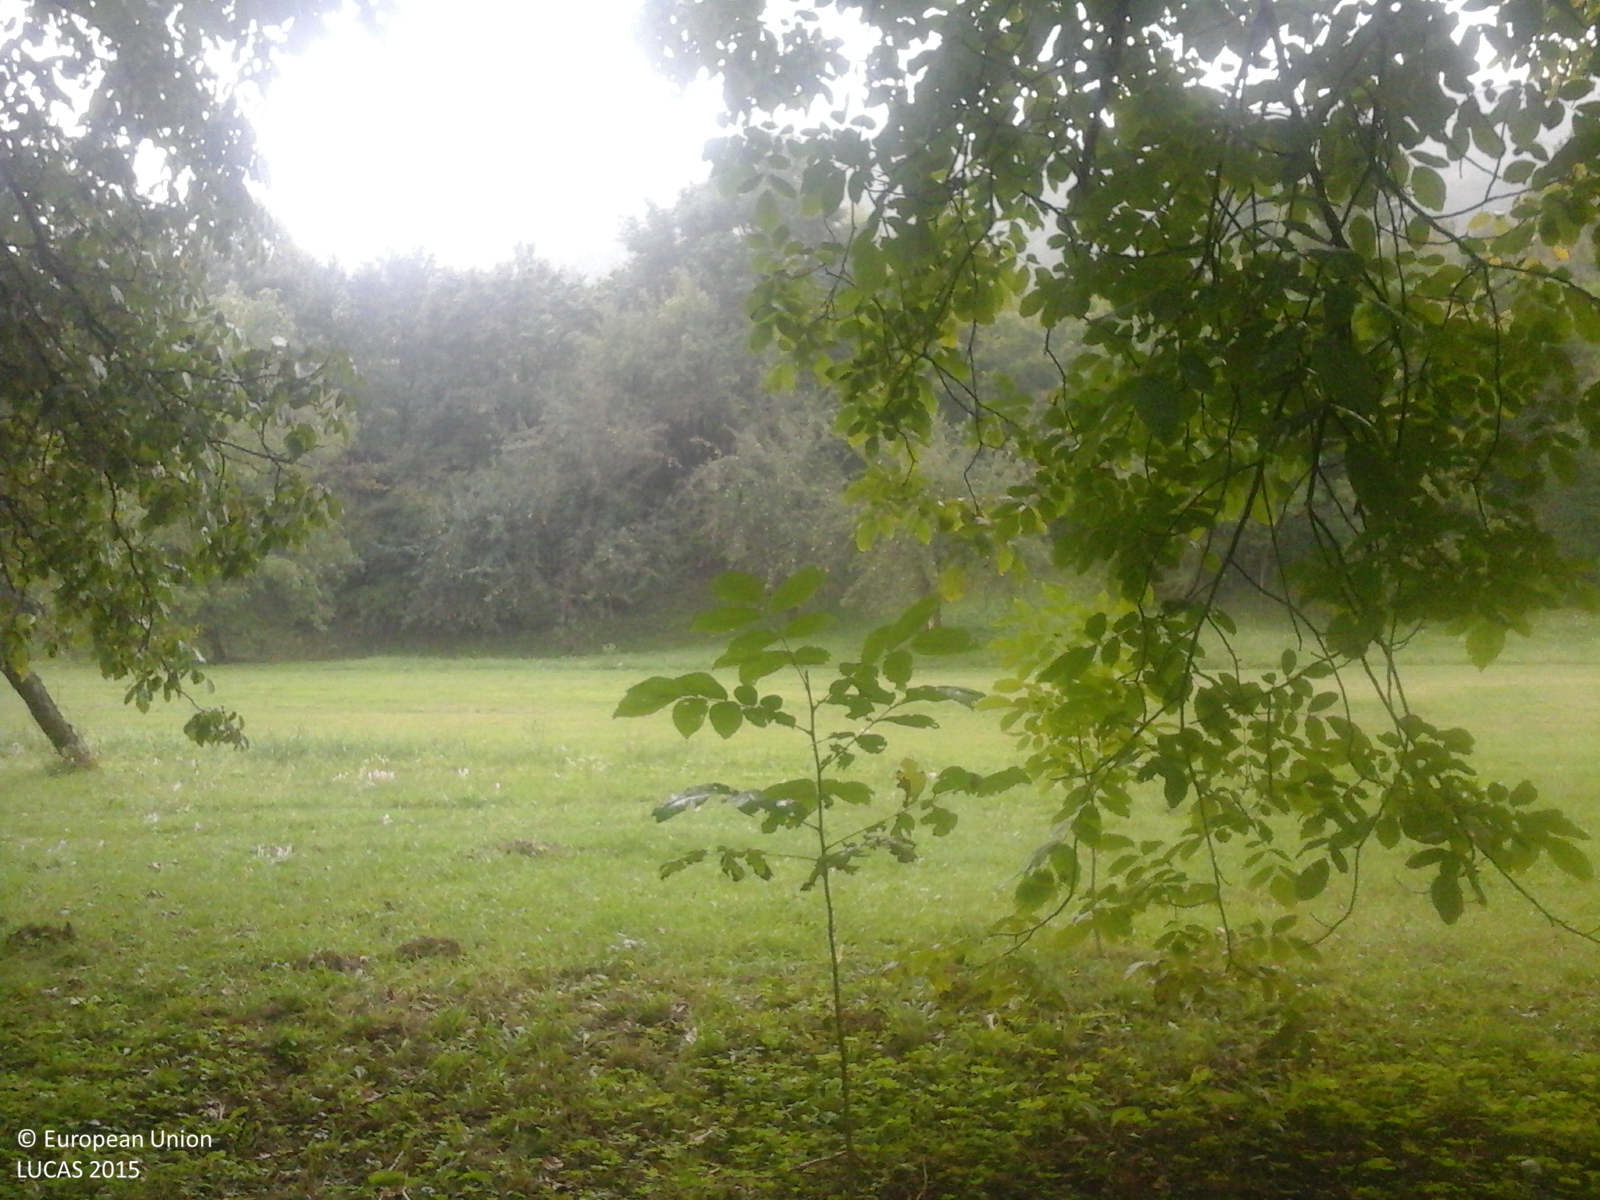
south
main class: Cropland
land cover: Nuts trees
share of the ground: > 75 %
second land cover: Grassland without tree/shrub cover
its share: < 10 %
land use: Agriculture (excluding fallow land and kitchen gardens)
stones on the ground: < 10 %
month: October
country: RO
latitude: 46.3510
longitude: 23.6225
